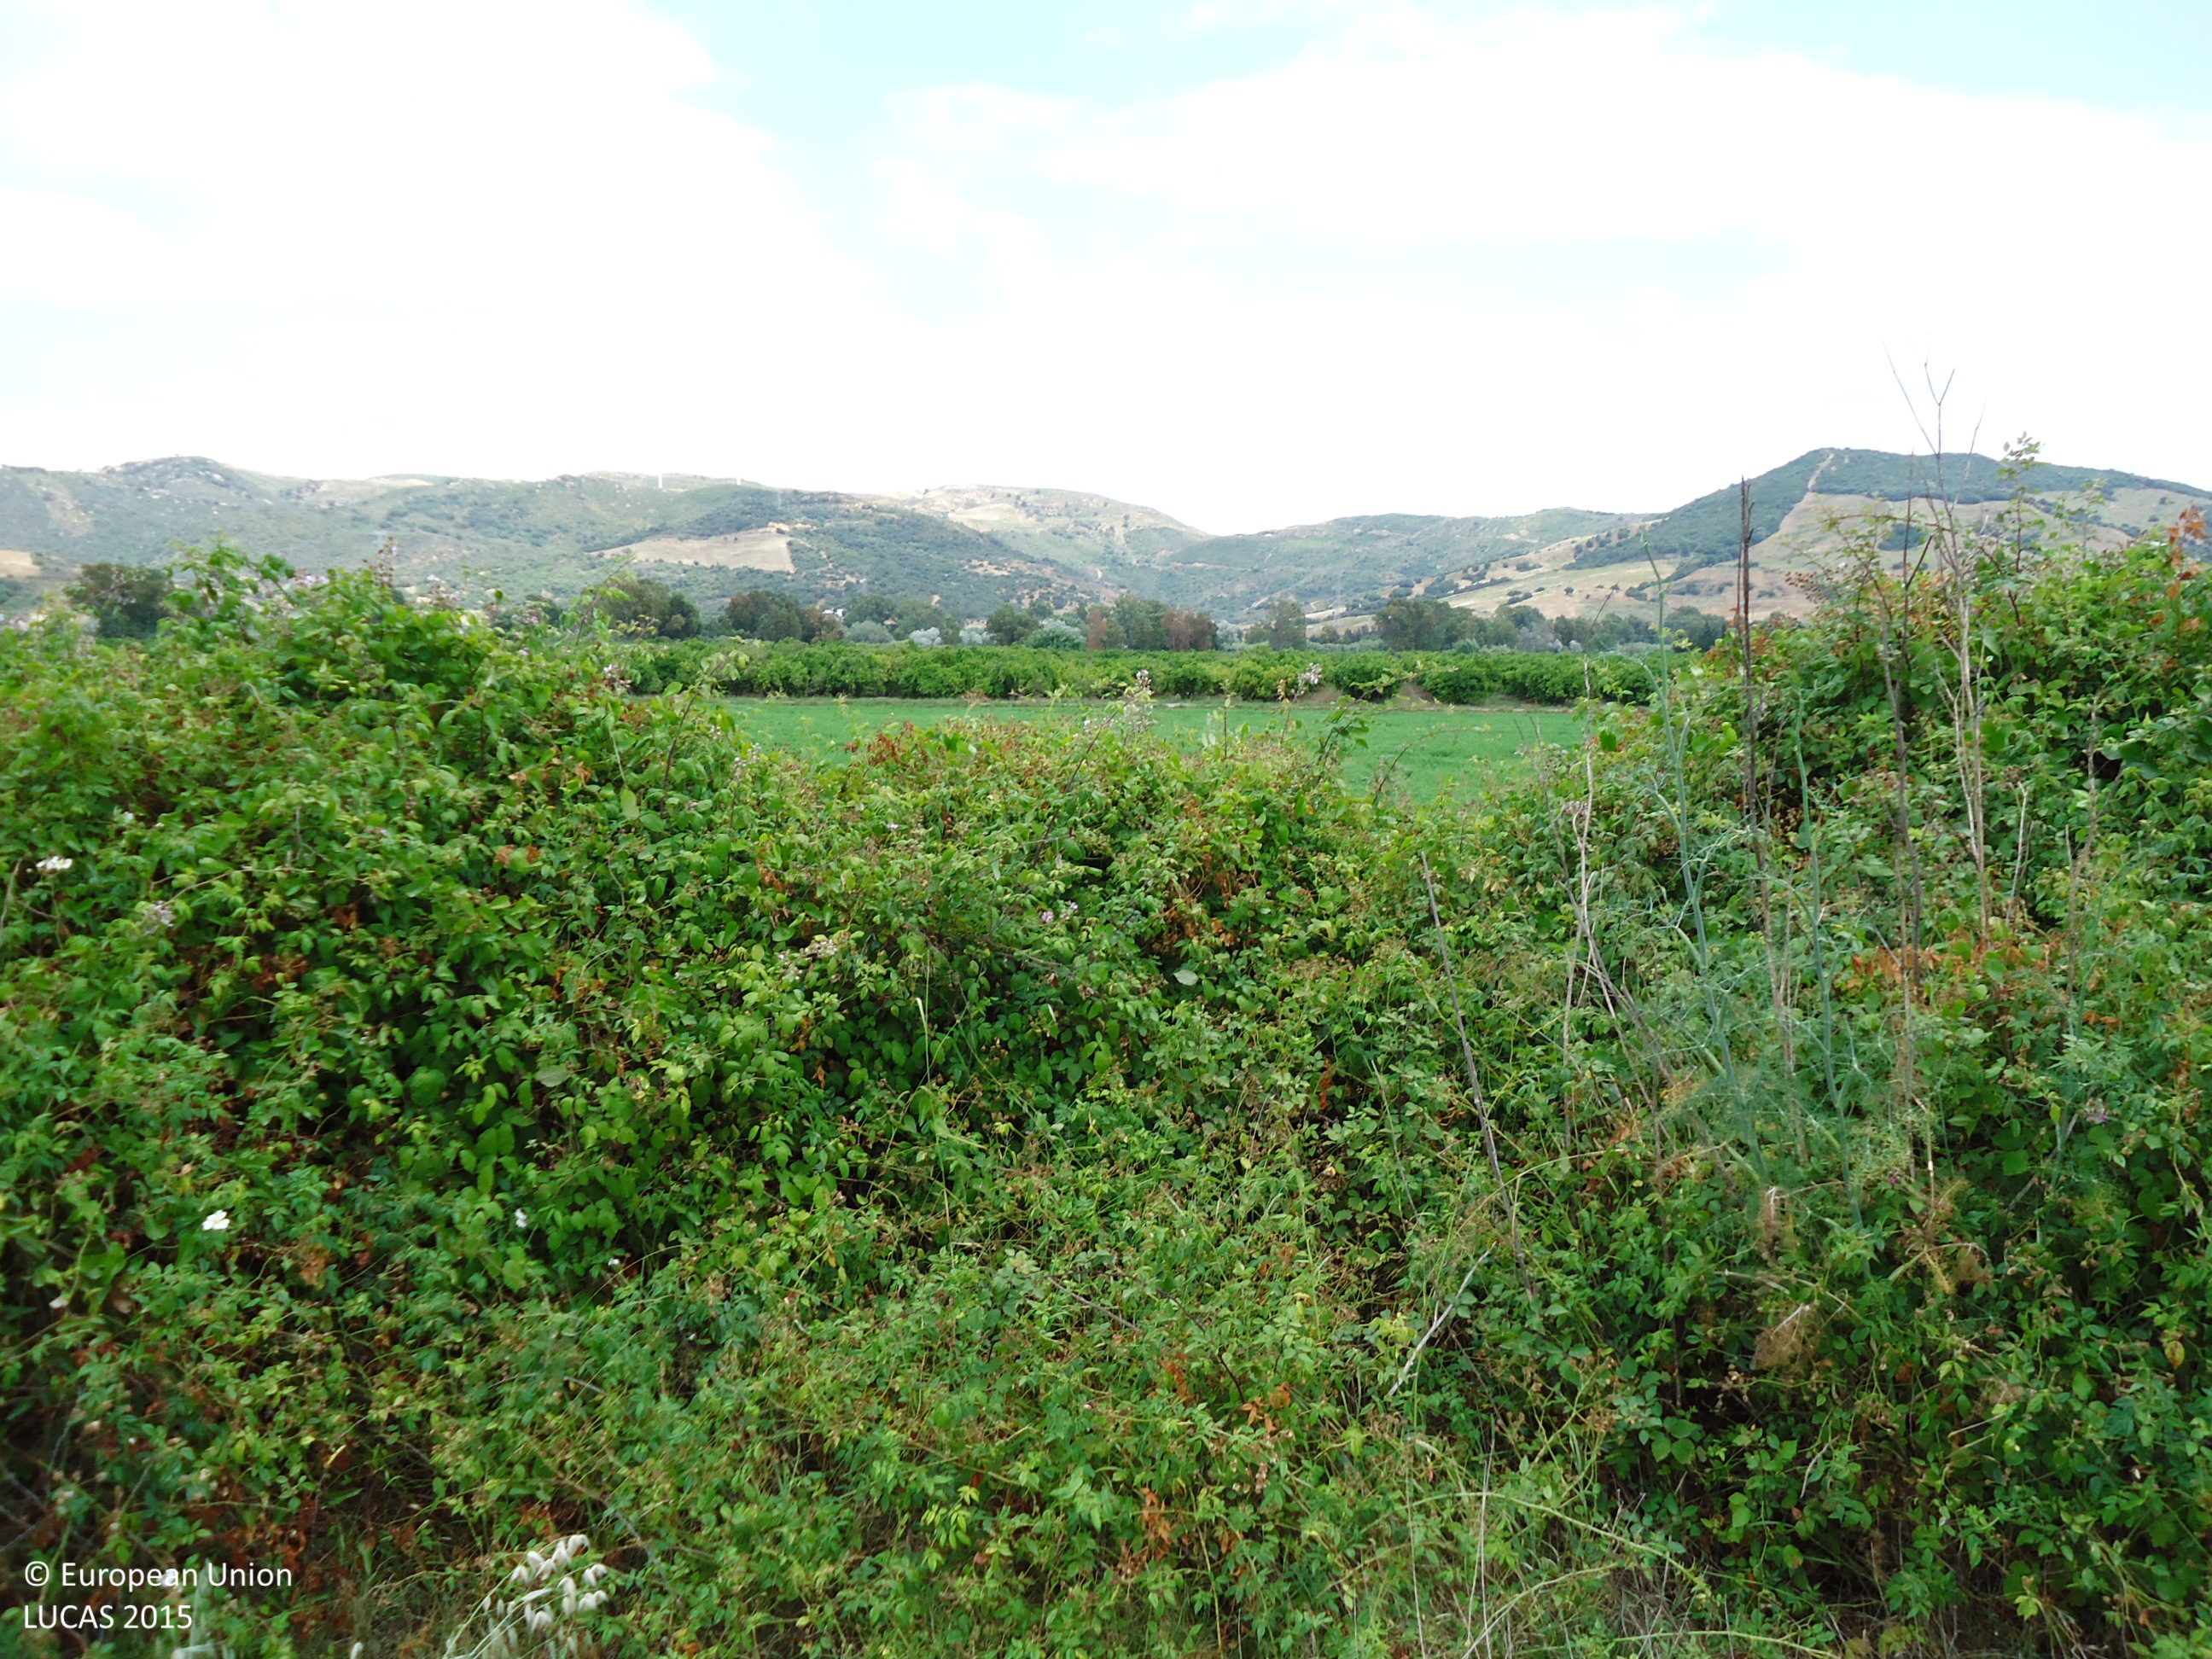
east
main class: Cropland
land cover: Lucerne
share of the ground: > 75 %
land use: Agriculture (excluding fallow land and kitchen gardens)
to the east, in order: Lucerne; Tracks; Oranges; Permanent crops (only in case pi); Tracks; Permanent crops (only in case pi)
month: June
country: ES
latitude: 36.3693
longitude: -5.3194
